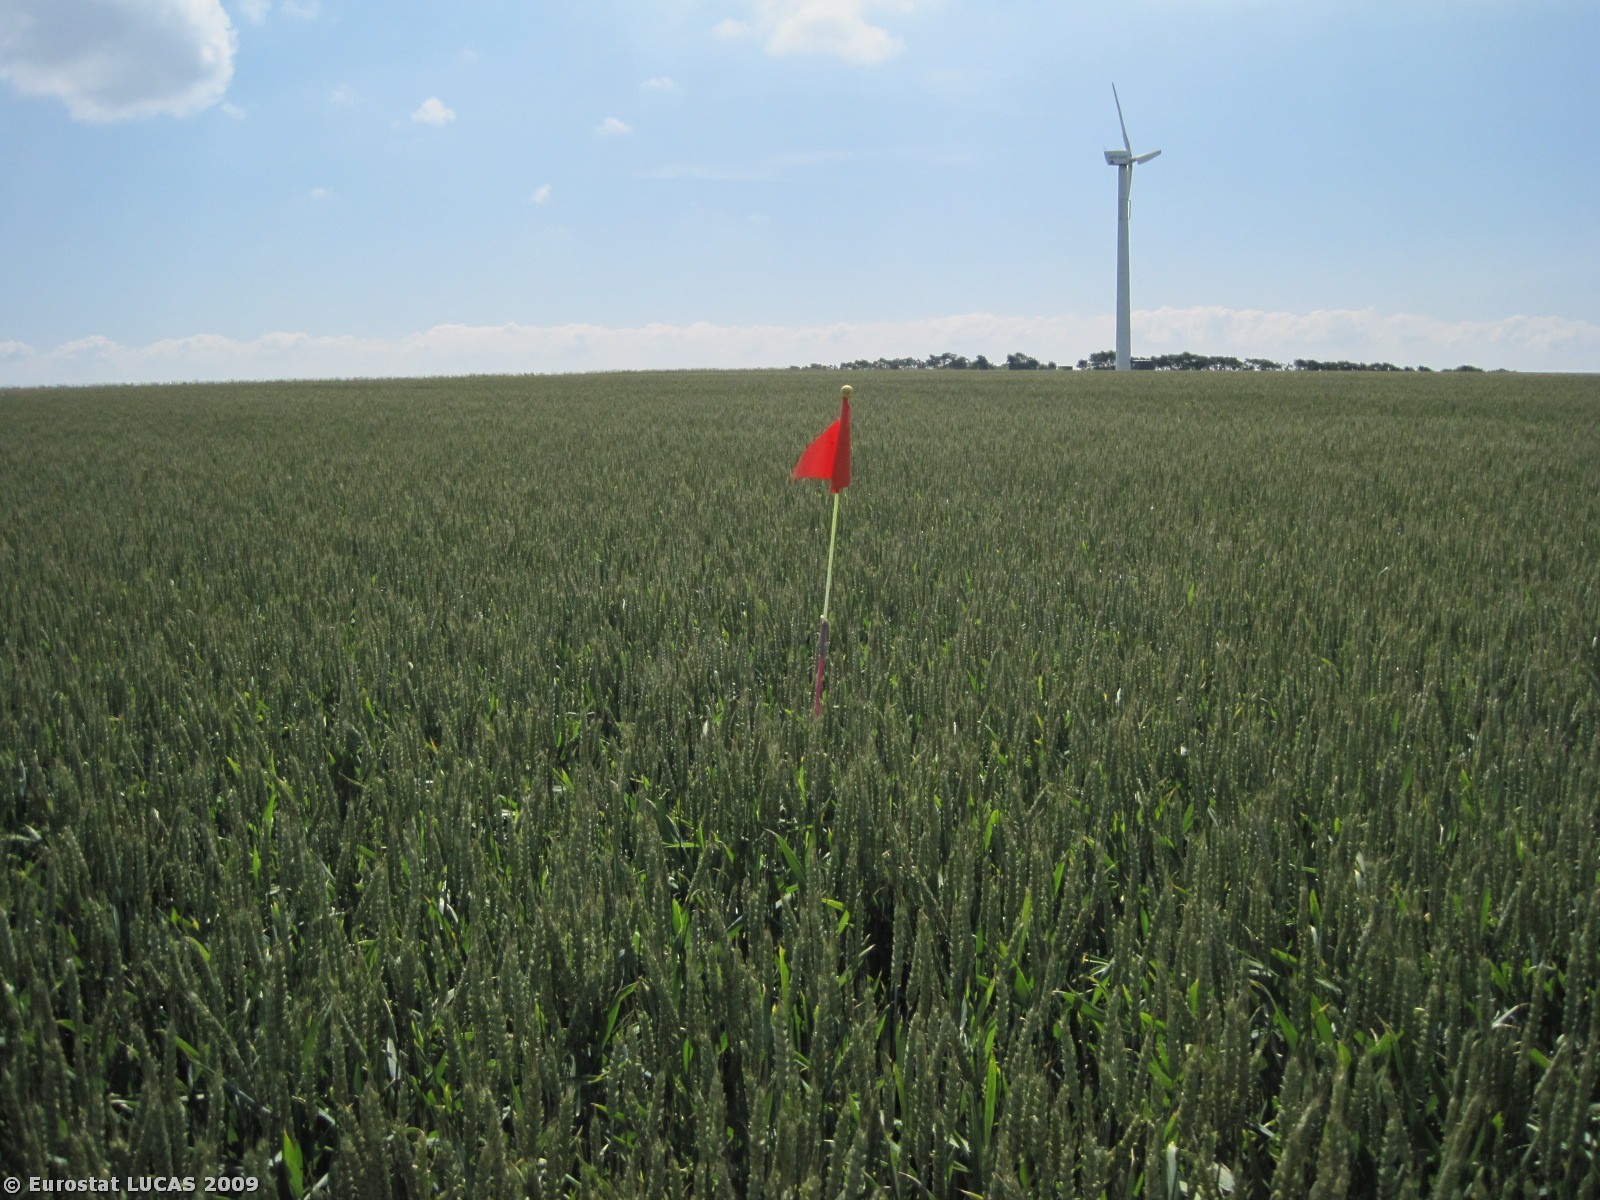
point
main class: Cropland
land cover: Common wheat
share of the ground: > 75 %
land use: Agriculture (excluding fallow land and kitchen gardens)
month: June
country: DK
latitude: 56.5427
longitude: 8.9117
